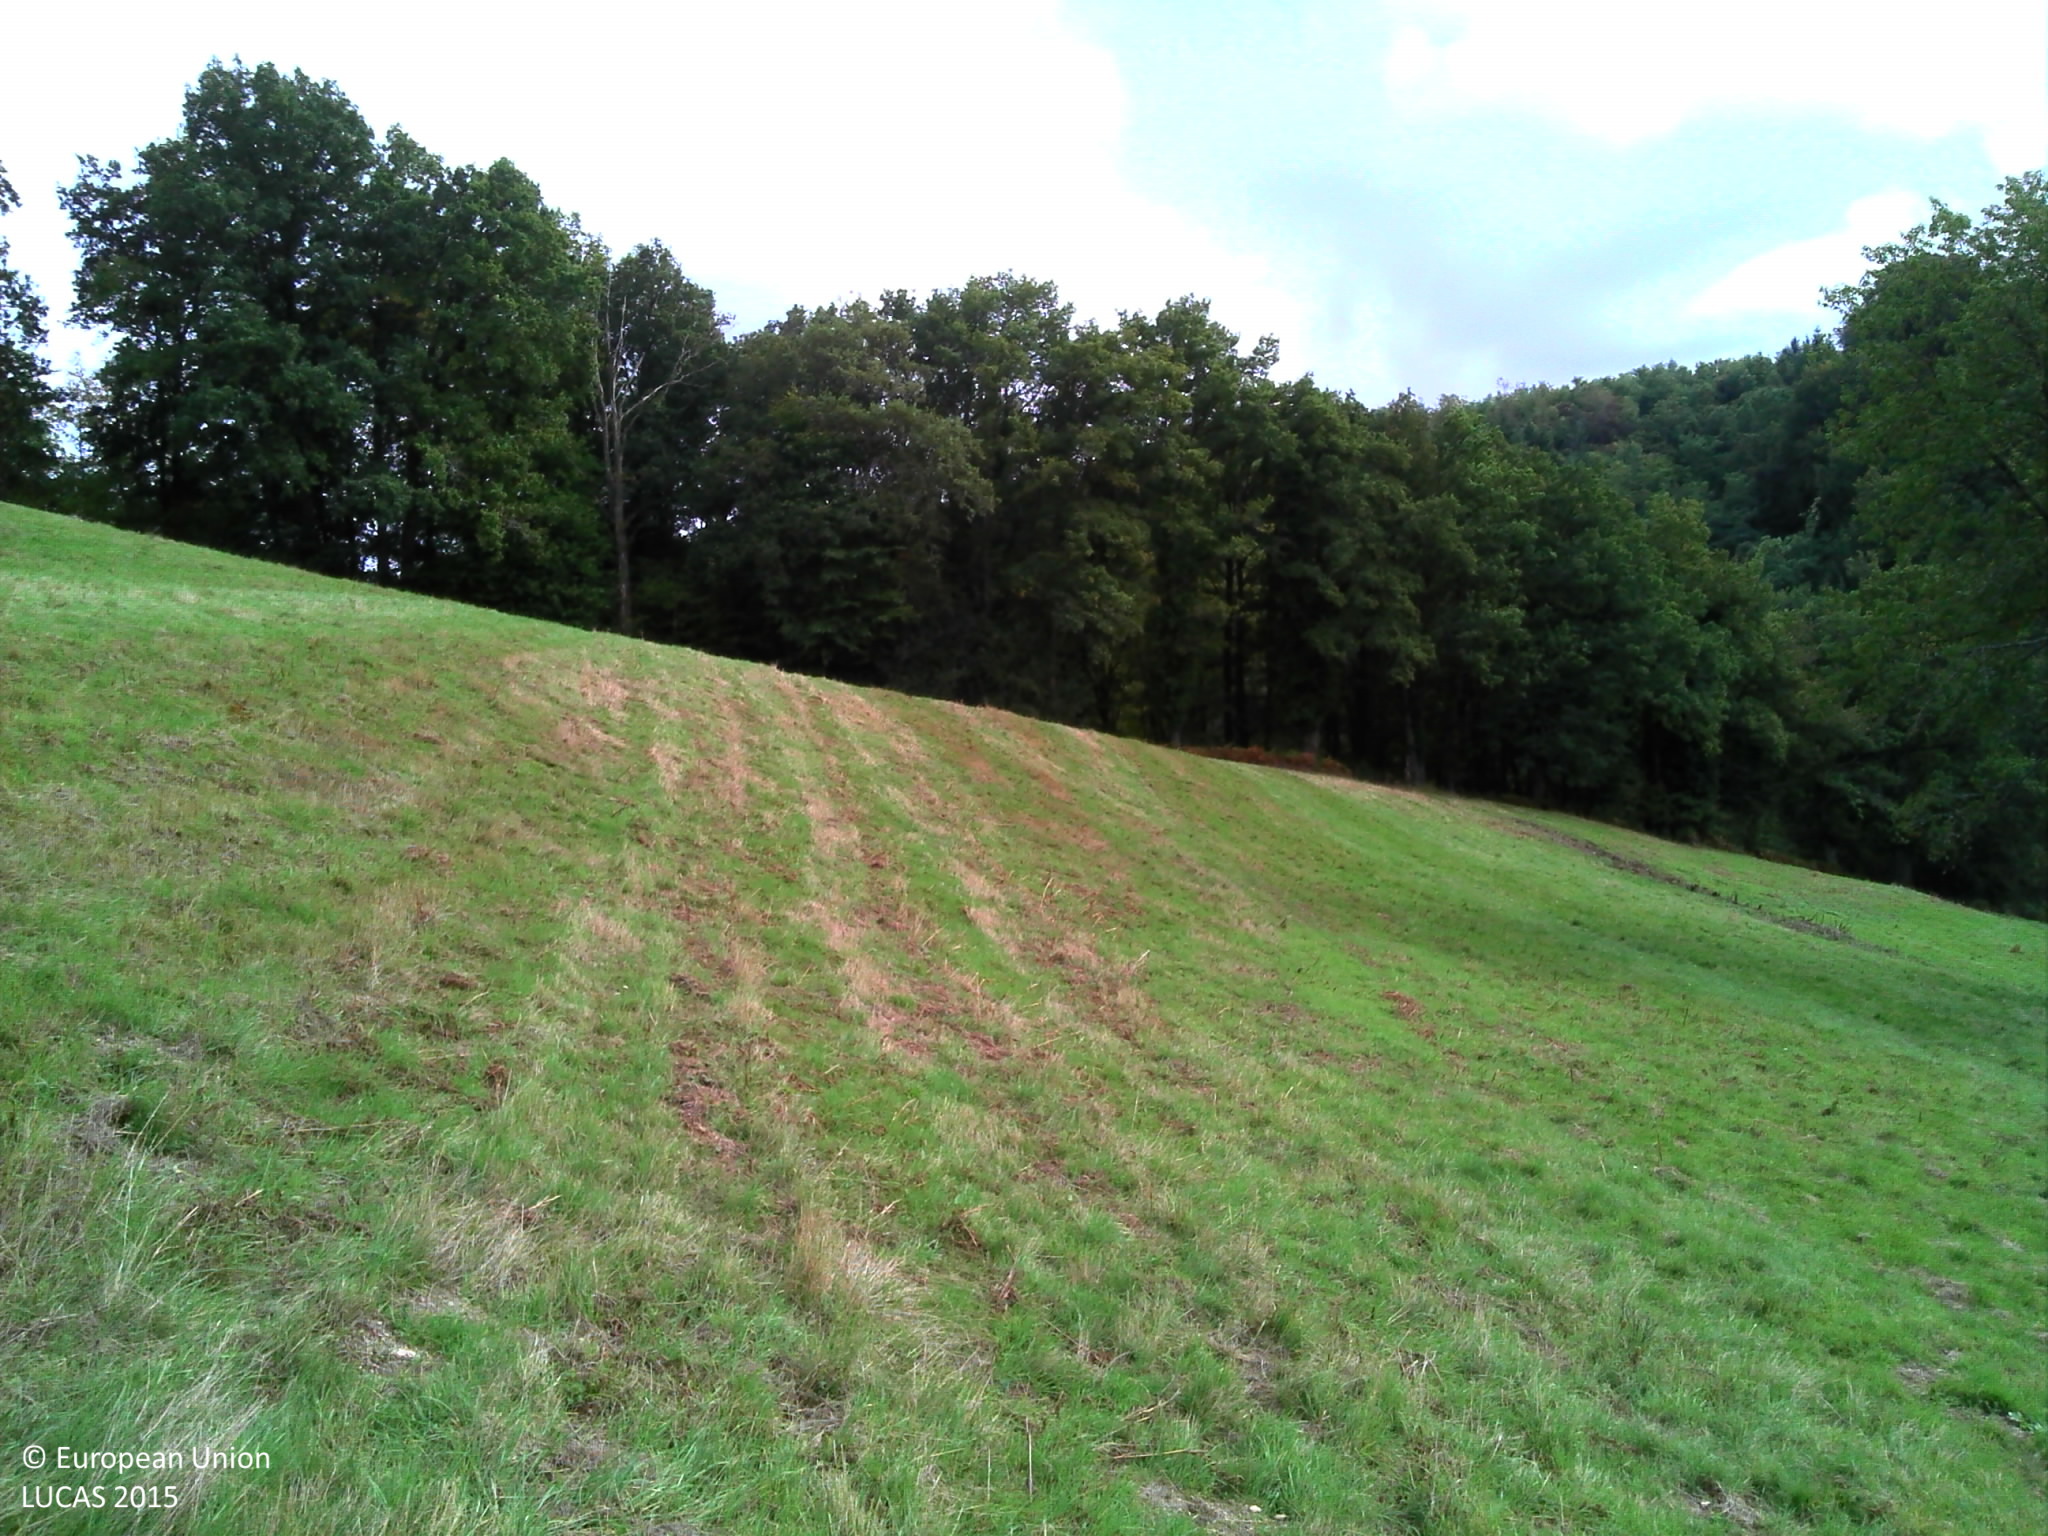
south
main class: Grassland
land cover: Grassland without tree/shrub cover
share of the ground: > 75 %
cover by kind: herbaceous plants 100 %
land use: Agriculture (excluding fallow land and kitchen gardens)
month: September
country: FR
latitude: 46.1830
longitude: 2.8333
